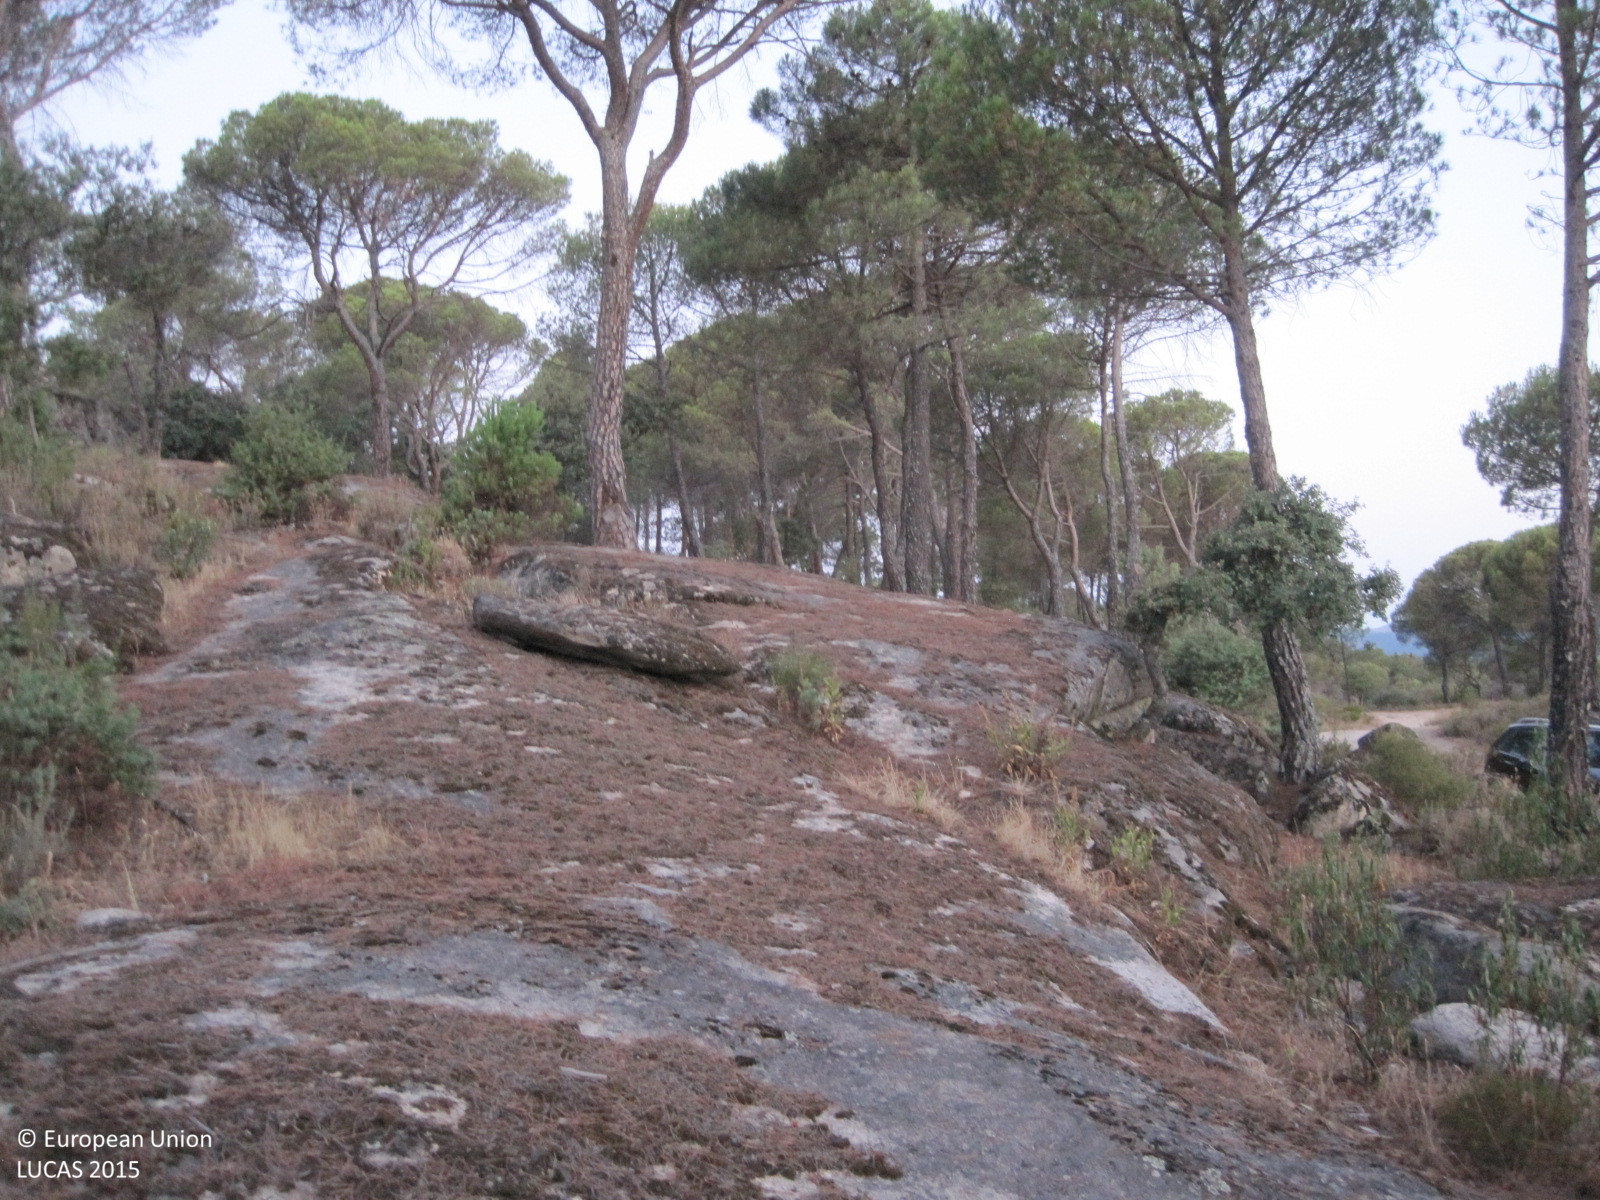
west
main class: Woodland
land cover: Pine dominated coniferous woodland
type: coniferous forest of the mediterranean region
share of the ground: > 75 %
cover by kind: coniferous forest trees 80 %, shrubs 20 %
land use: Forestry
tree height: > 5 m
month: July
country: ES
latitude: 40.3190
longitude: -4.3915
